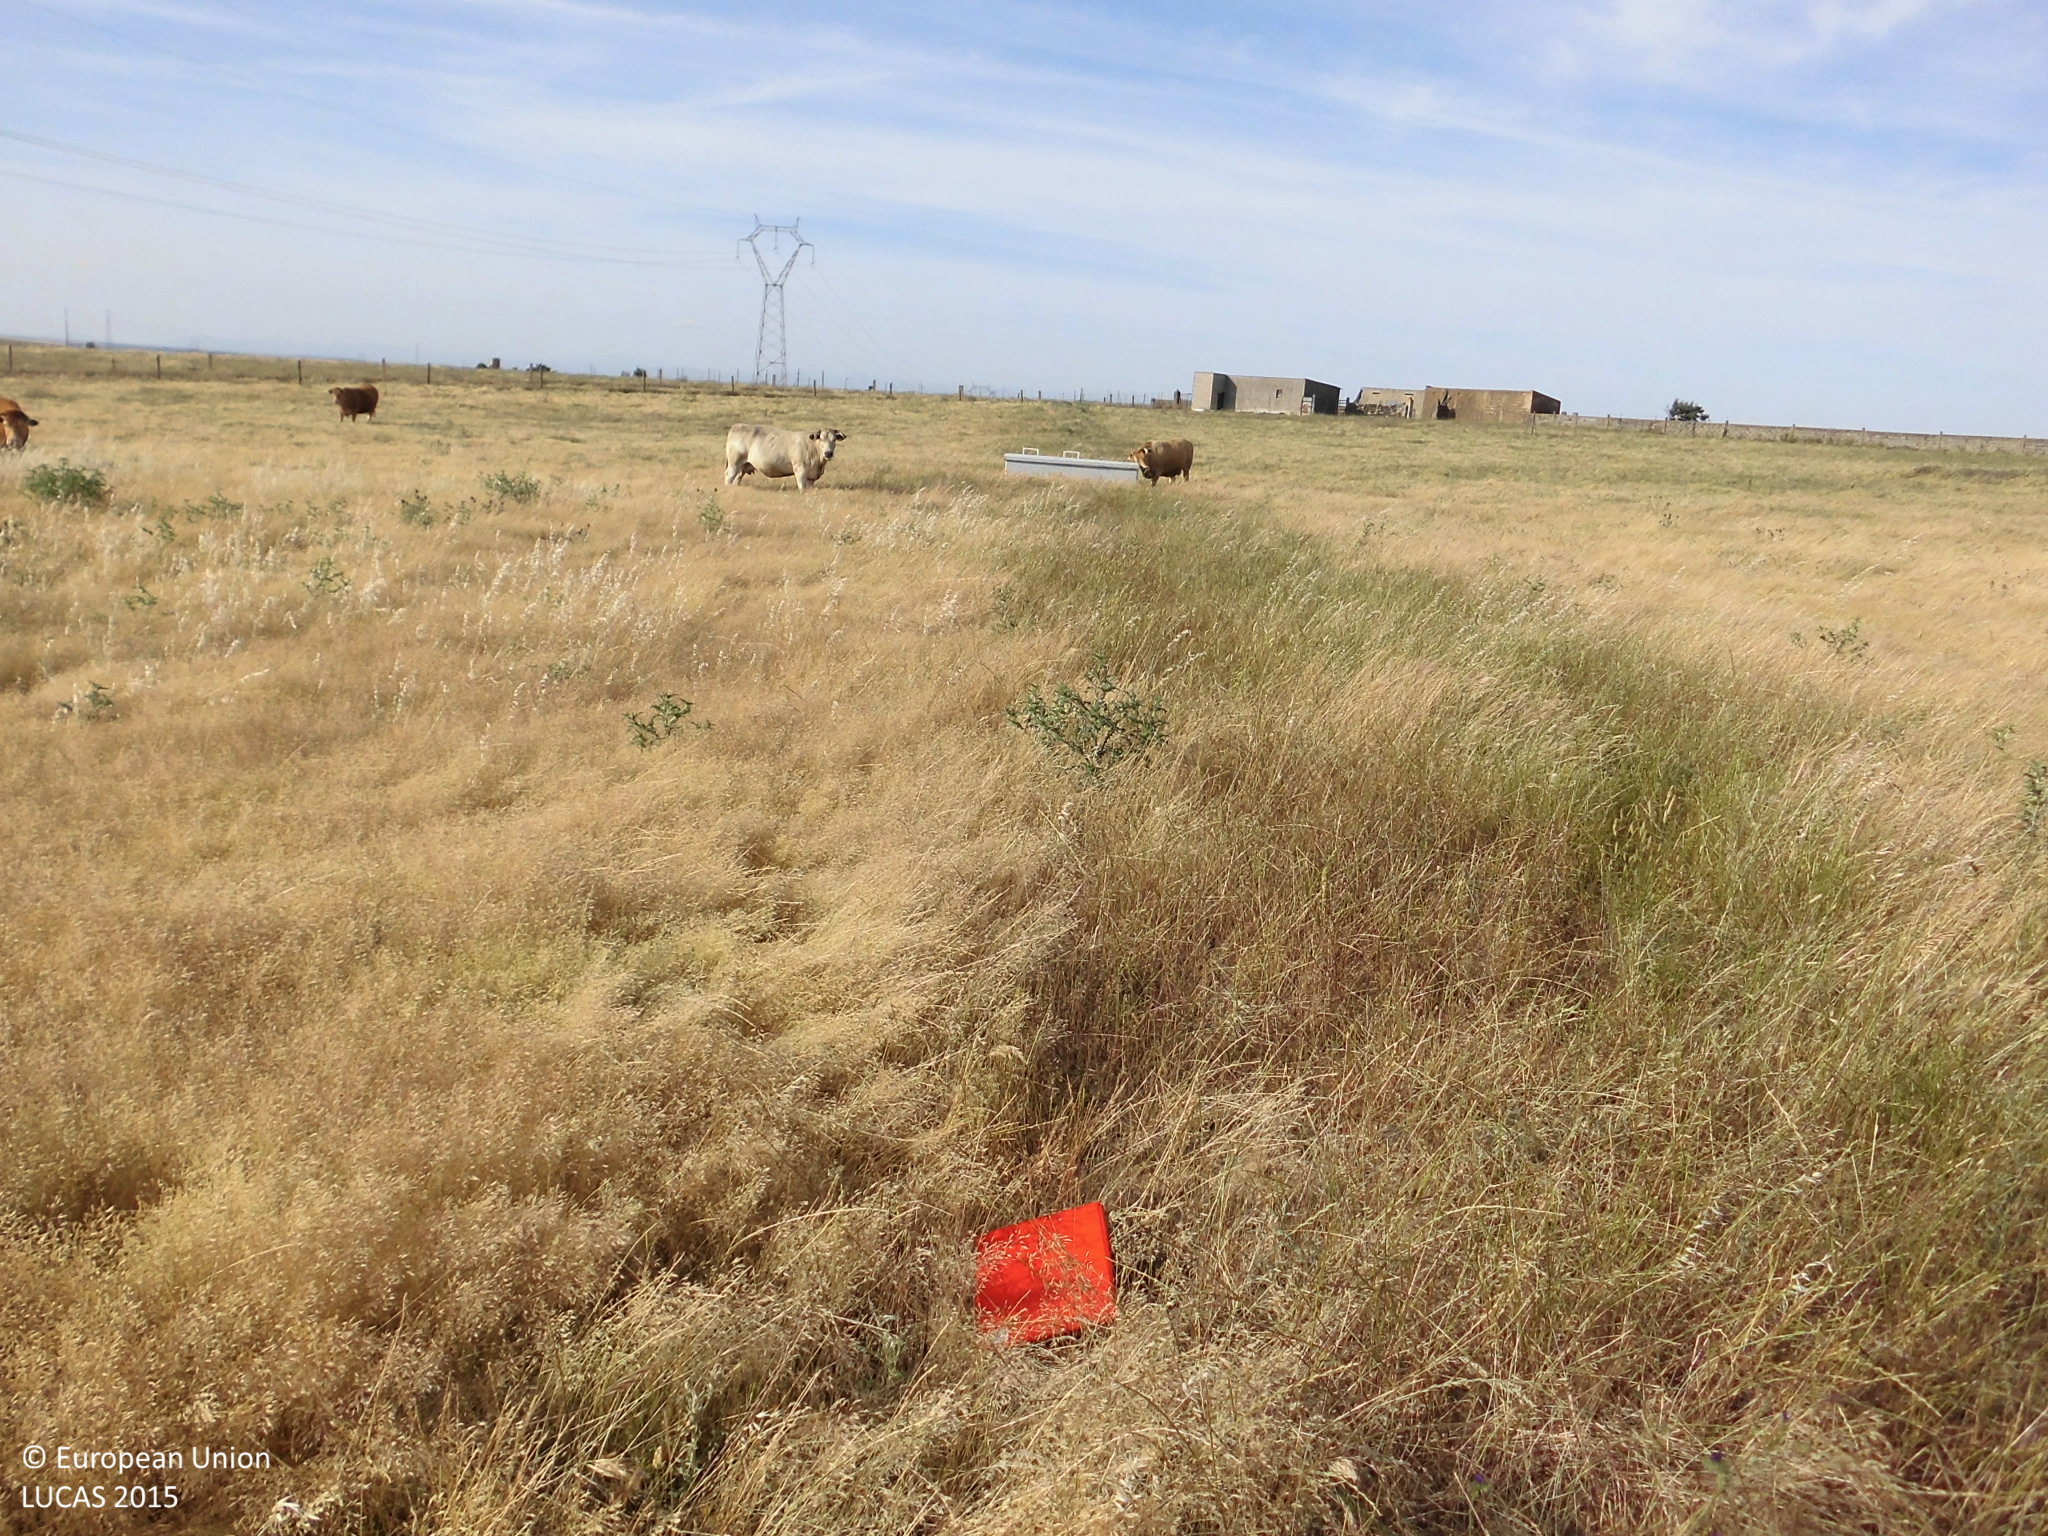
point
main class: Grassland
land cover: Grassland without tree/shrub cover
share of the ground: > 75 %
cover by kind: herbaceous plants 100 %
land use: Agriculture (excluding fallow land and kitchen gardens)
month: May
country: ES
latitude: 39.4154
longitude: -5.9360
